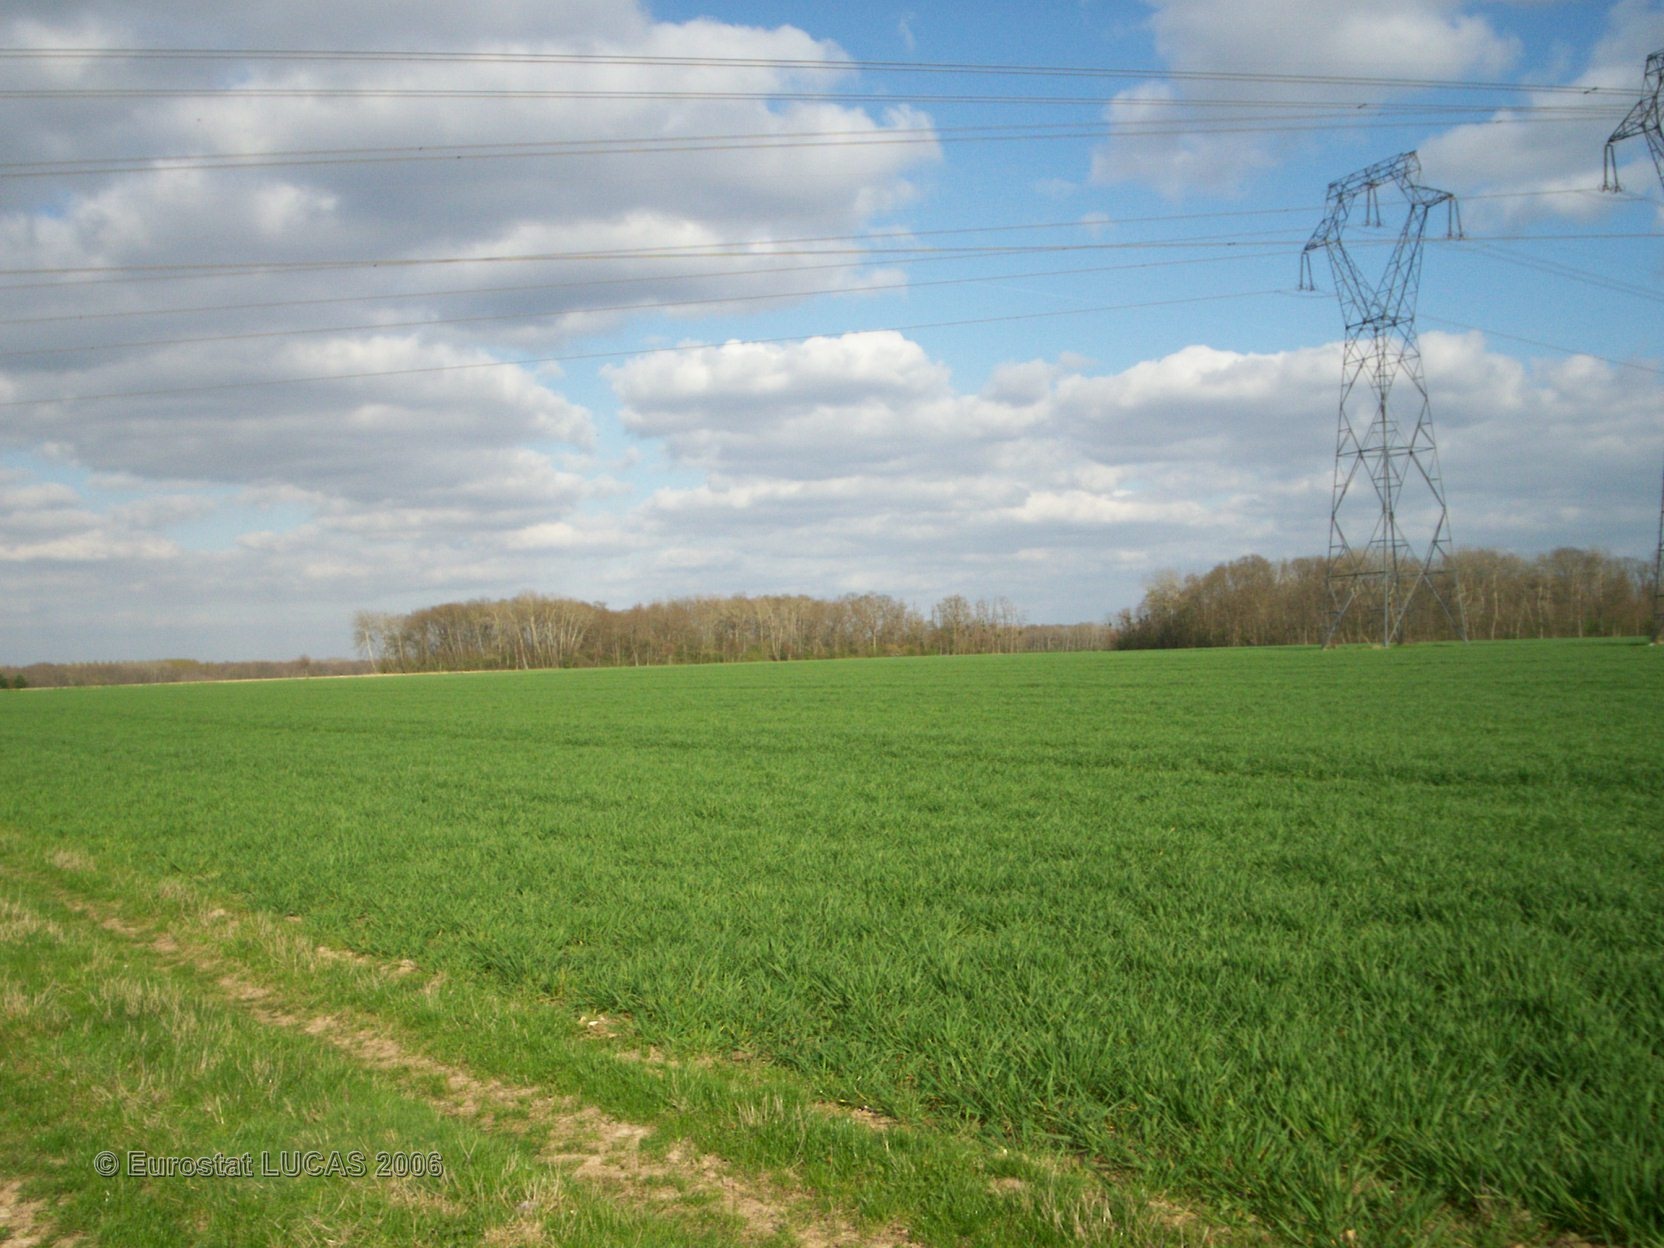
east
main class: Cropland
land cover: Maize
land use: Agriculture (excluding fallow land and kitchen gardens)
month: May
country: FR
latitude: 48.4780
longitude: 2.8349
